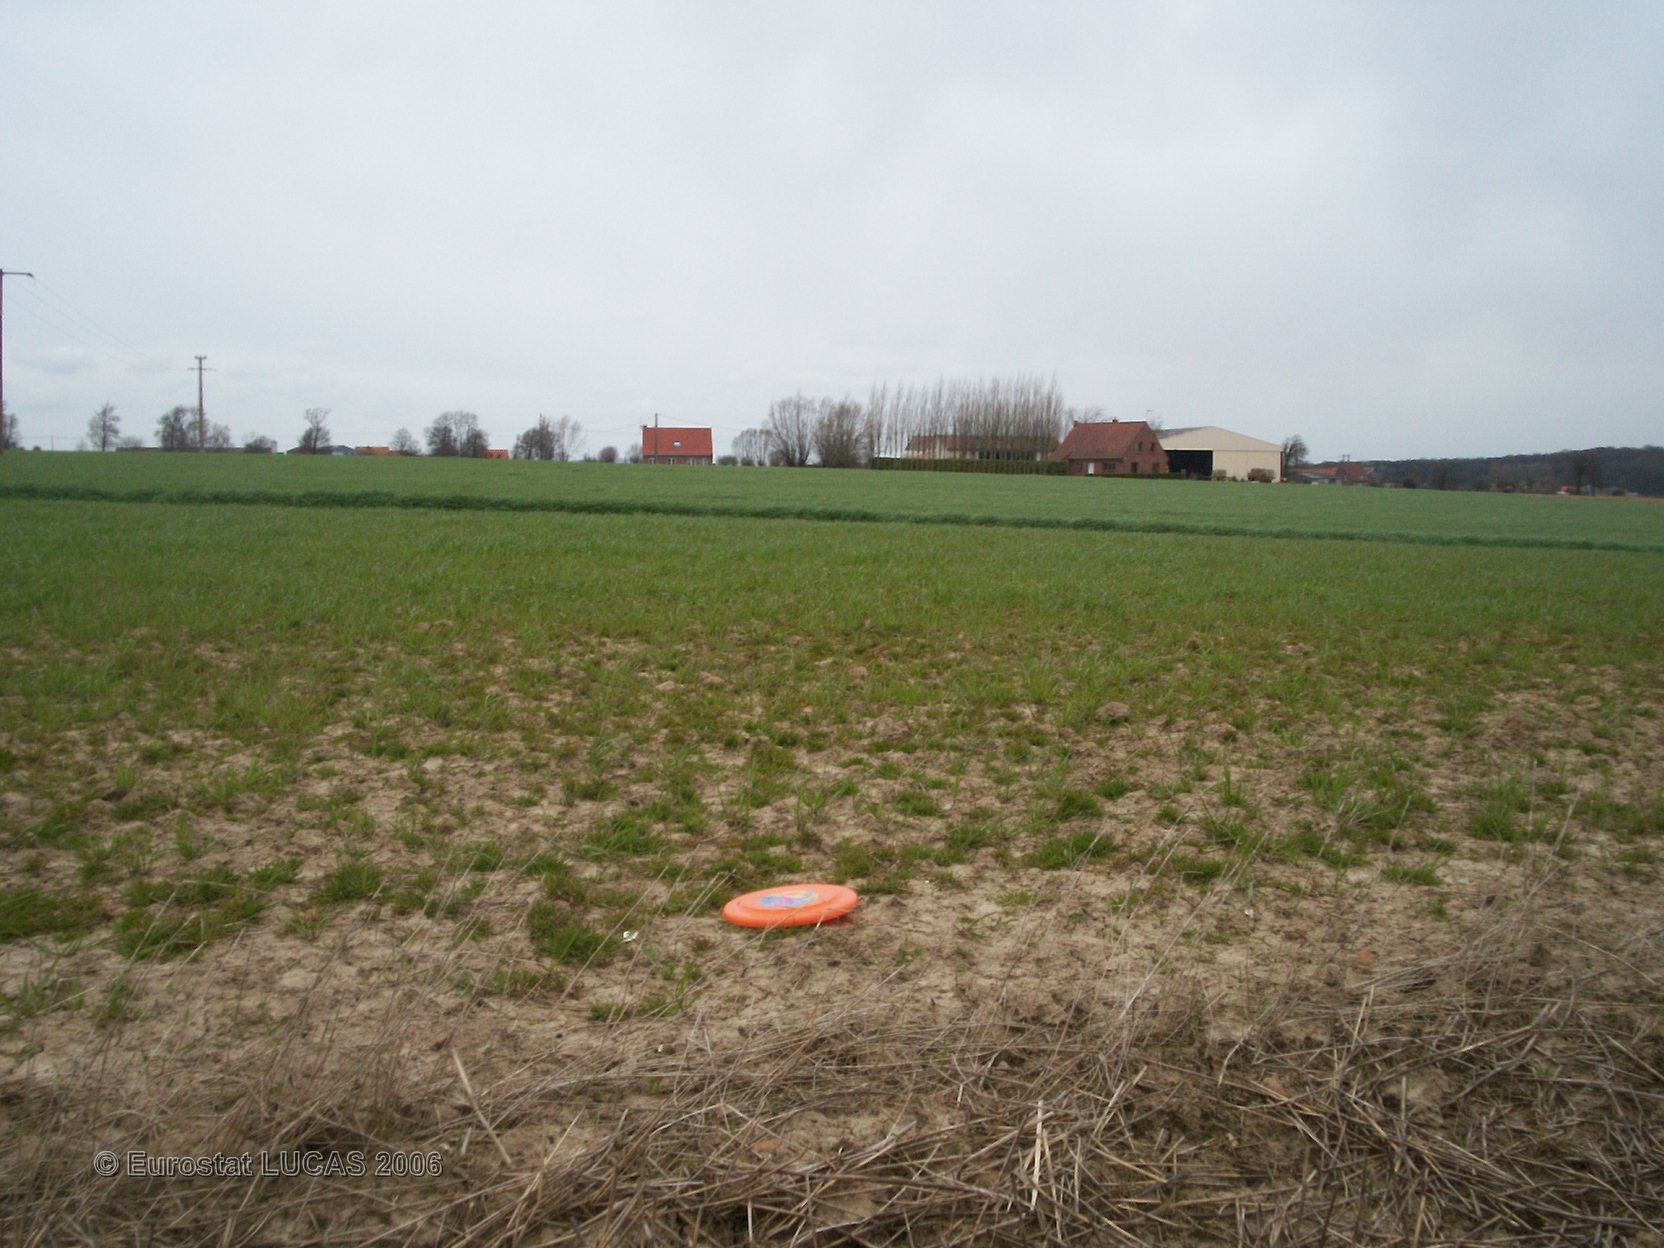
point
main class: Cropland
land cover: Oats
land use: Agriculture (excluding fallow land and kitchen gardens)
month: April
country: FR
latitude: 50.6936
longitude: 2.4700
